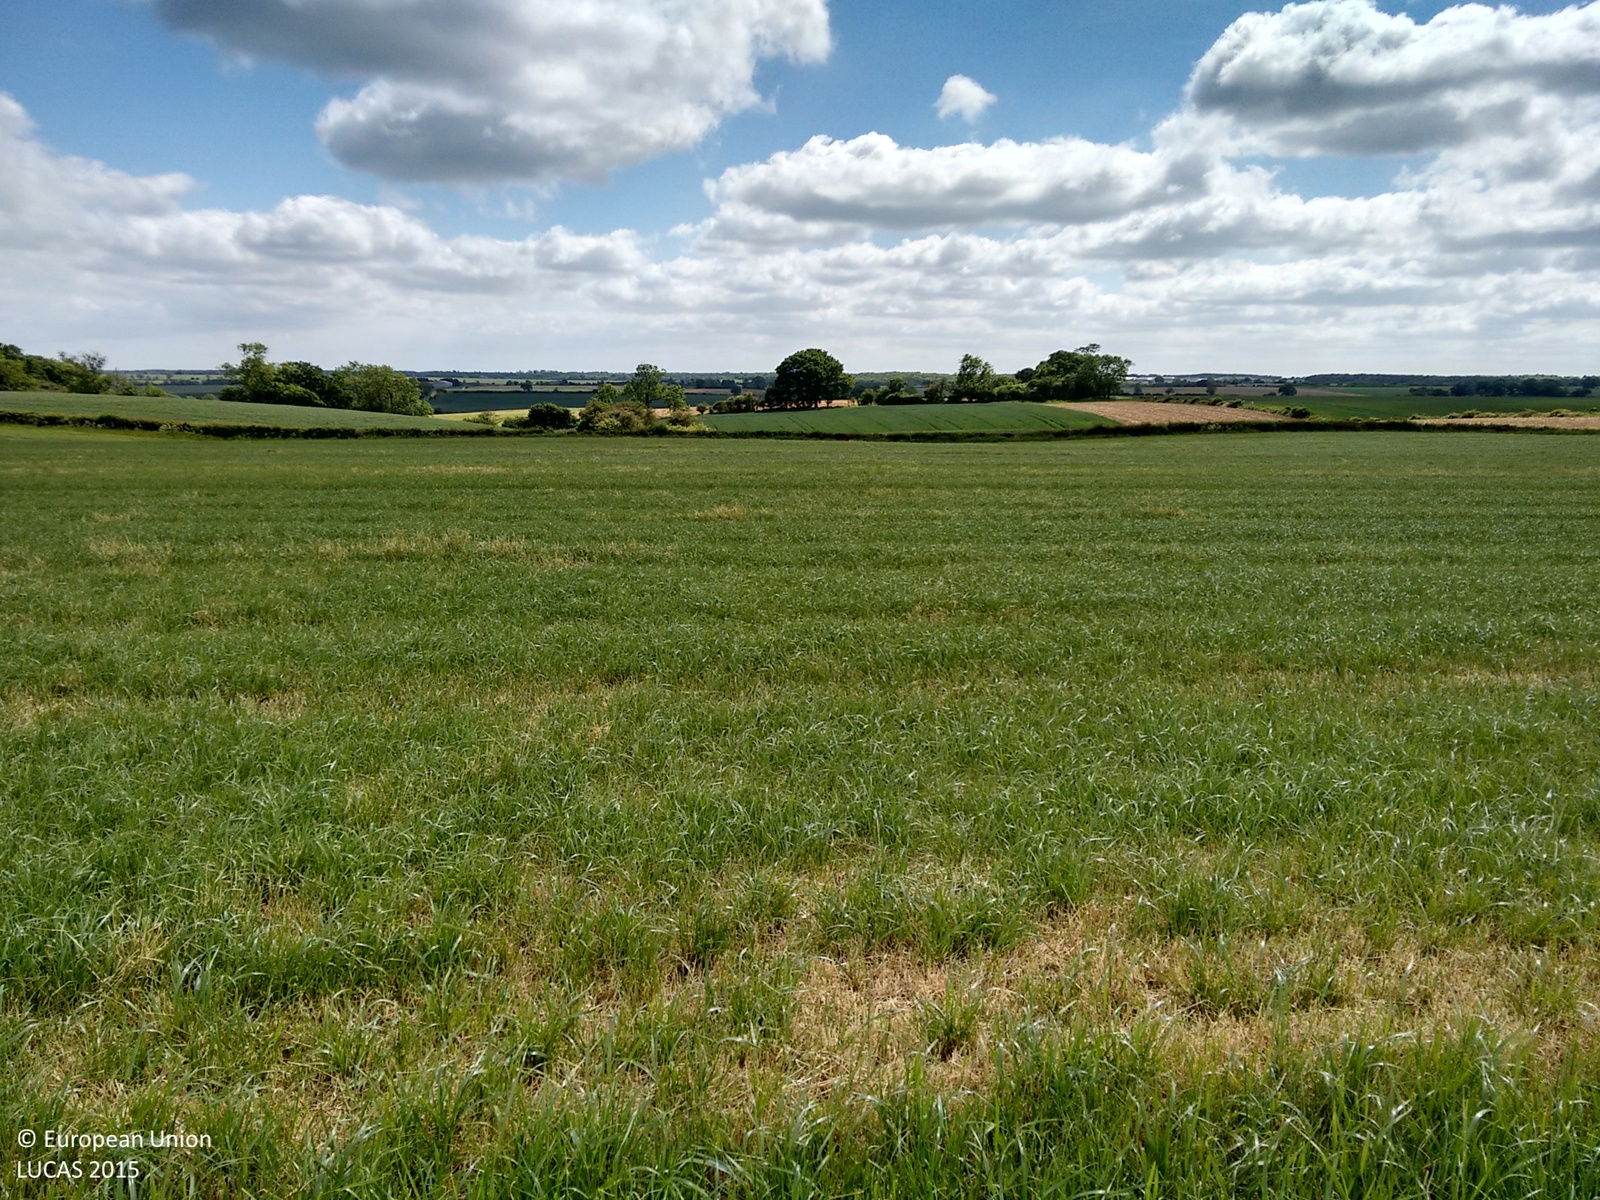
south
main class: Grassland
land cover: Grassland without tree/shrub cover
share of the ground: > 75 %
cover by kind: herbaceous plants 100 %
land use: Agriculture (excluding fallow land and kitchen gardens)
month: June
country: GB
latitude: 52.7766
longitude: -0.5488
